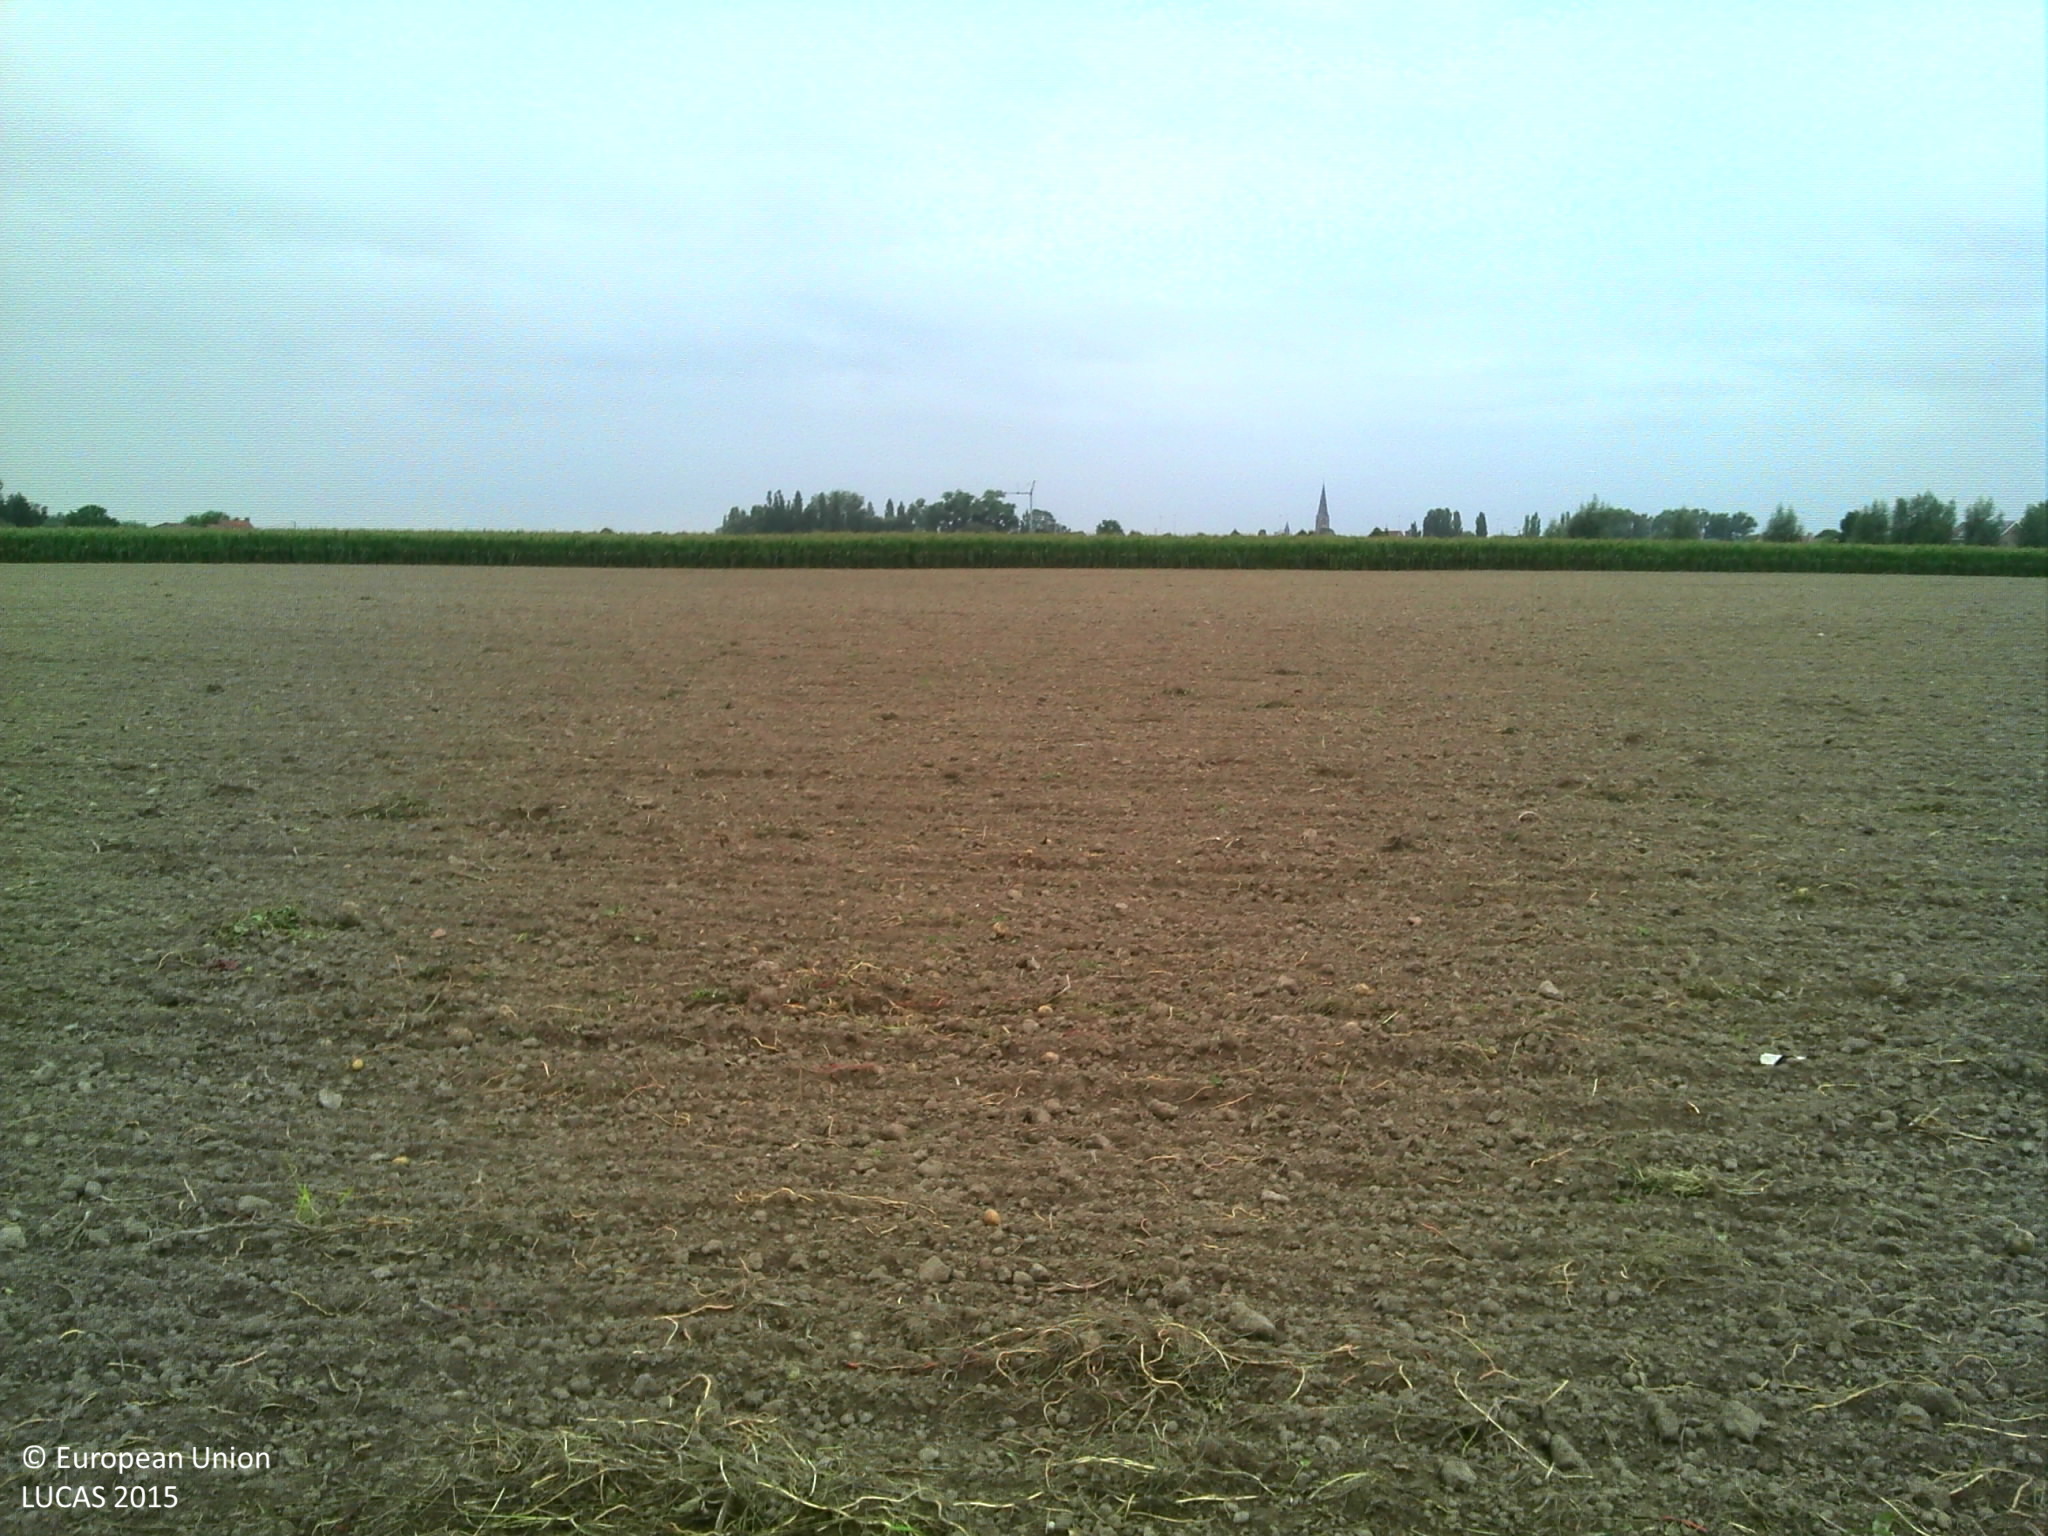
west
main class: Grassland
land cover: Grassland without tree/shrub cover
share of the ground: > 75 %
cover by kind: herbaceous plants 100 %
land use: Agriculture (excluding fallow land and kitchen gardens)
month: September
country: BE
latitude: 51.0403
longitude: 3.4170
